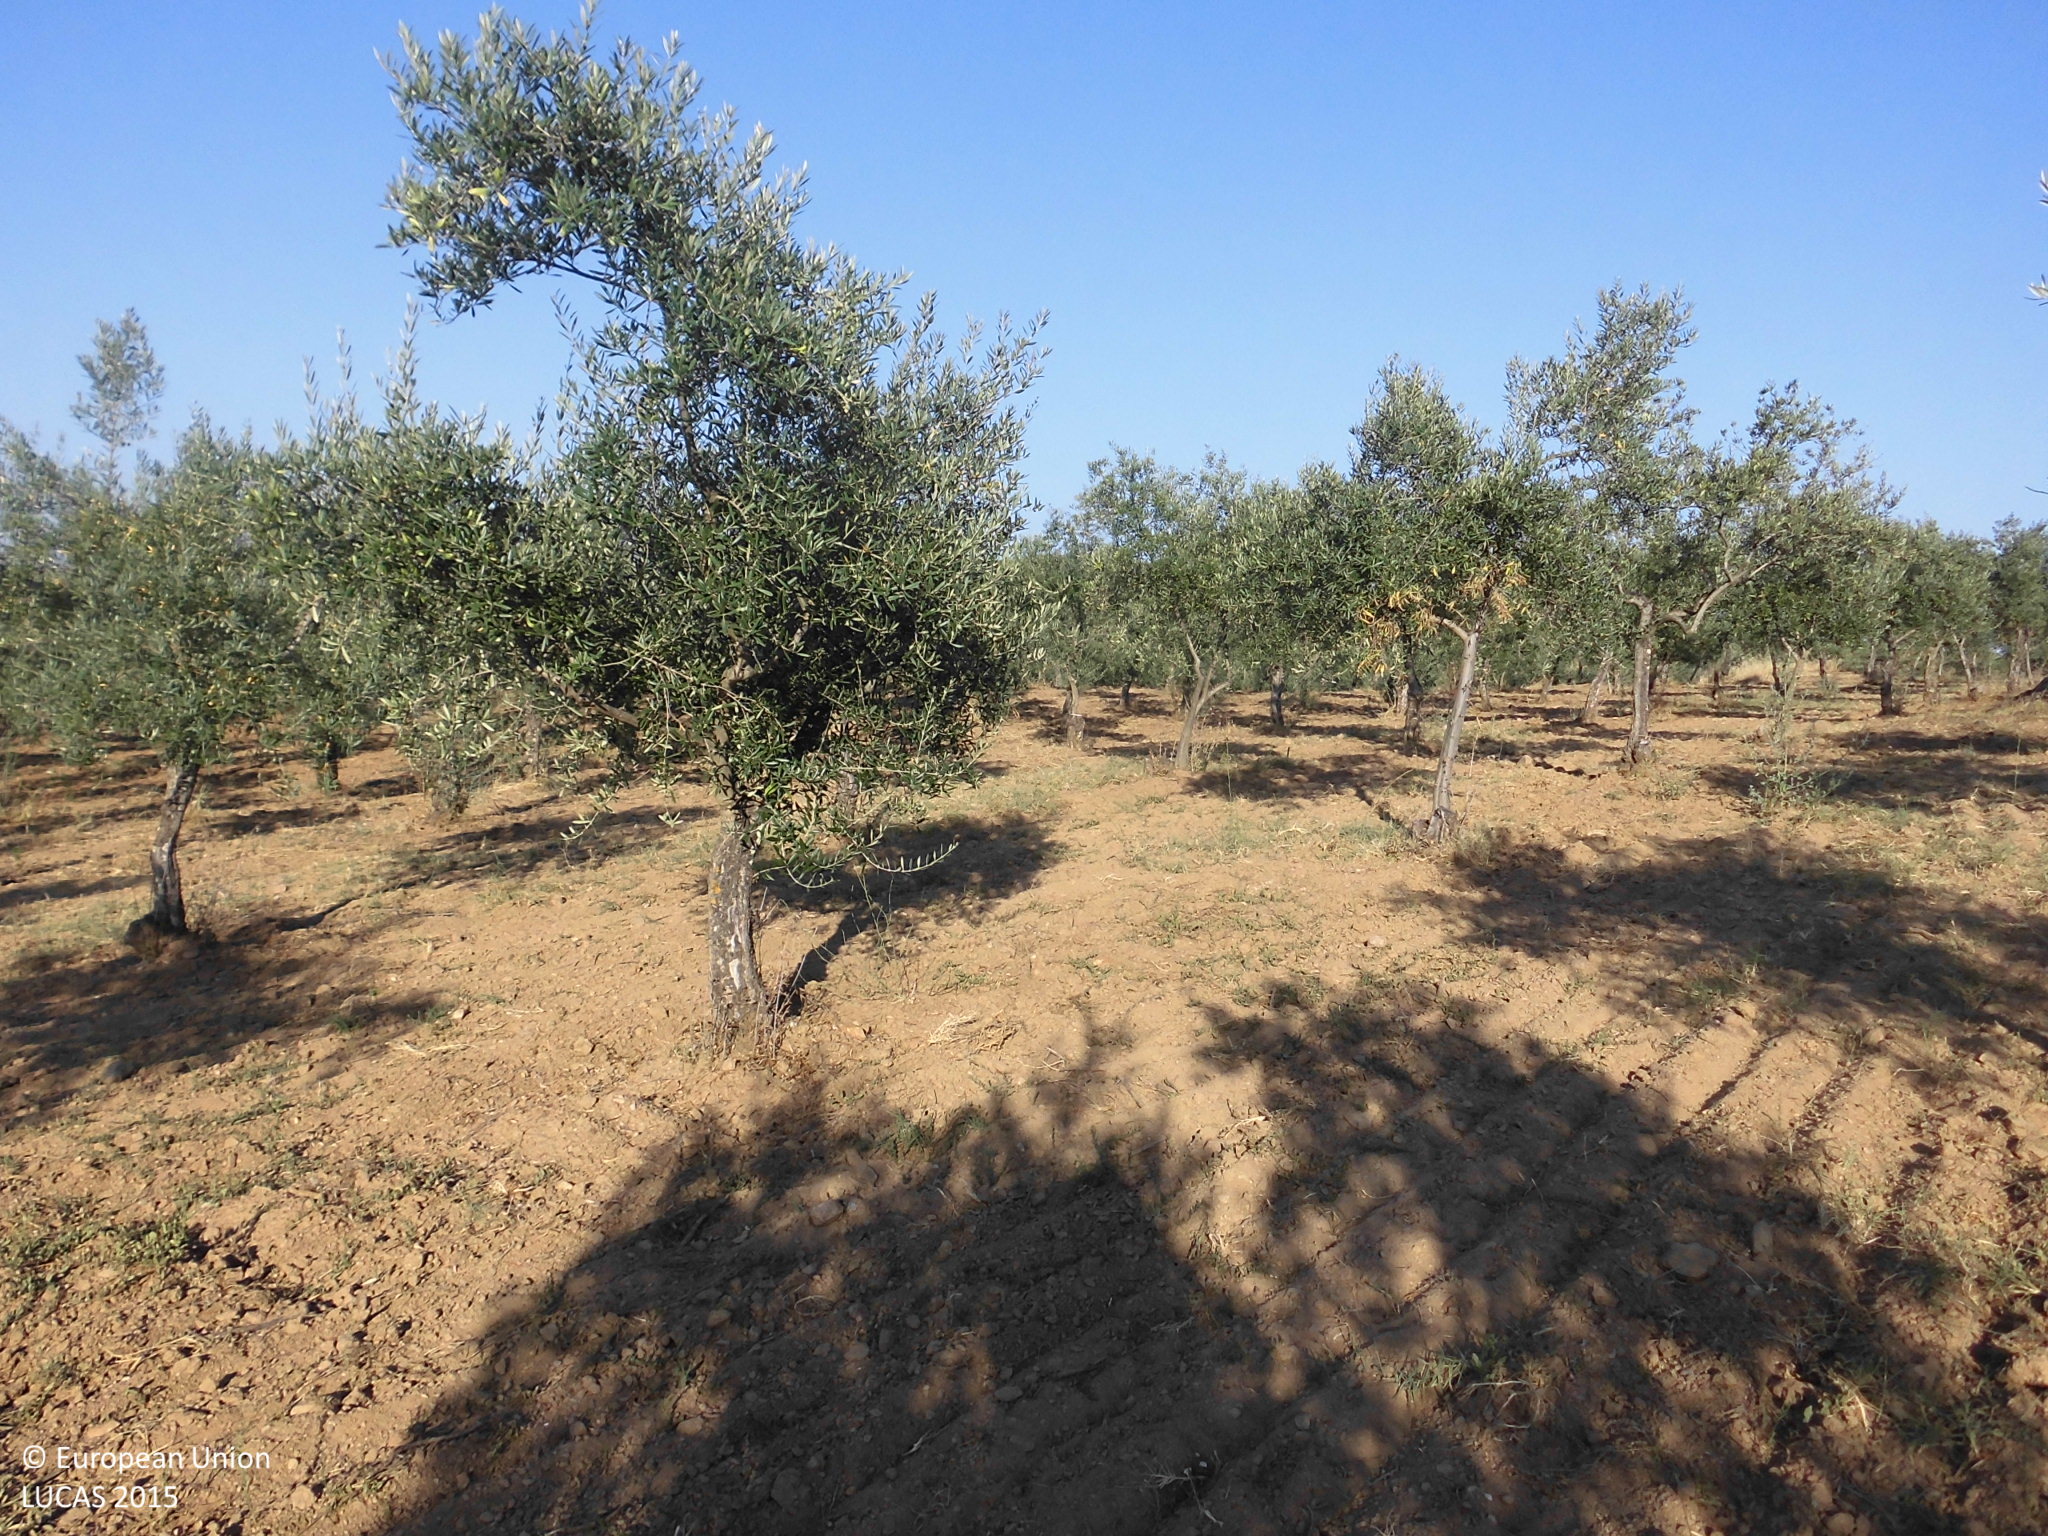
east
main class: Cropland
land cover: Olive groves
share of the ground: 25 - 50 %
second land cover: Other bare soil
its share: > 75 %
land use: Agriculture (excluding fallow land and kitchen gardens)
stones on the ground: < 10 %
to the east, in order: Olive groves; Other bare soil; Fences; Olive groves; Fences; Tracks; Fences; Olive groves; Fences; Shrubland with sparse tree cover
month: July
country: ES
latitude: 40.1632
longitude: -6.1965
